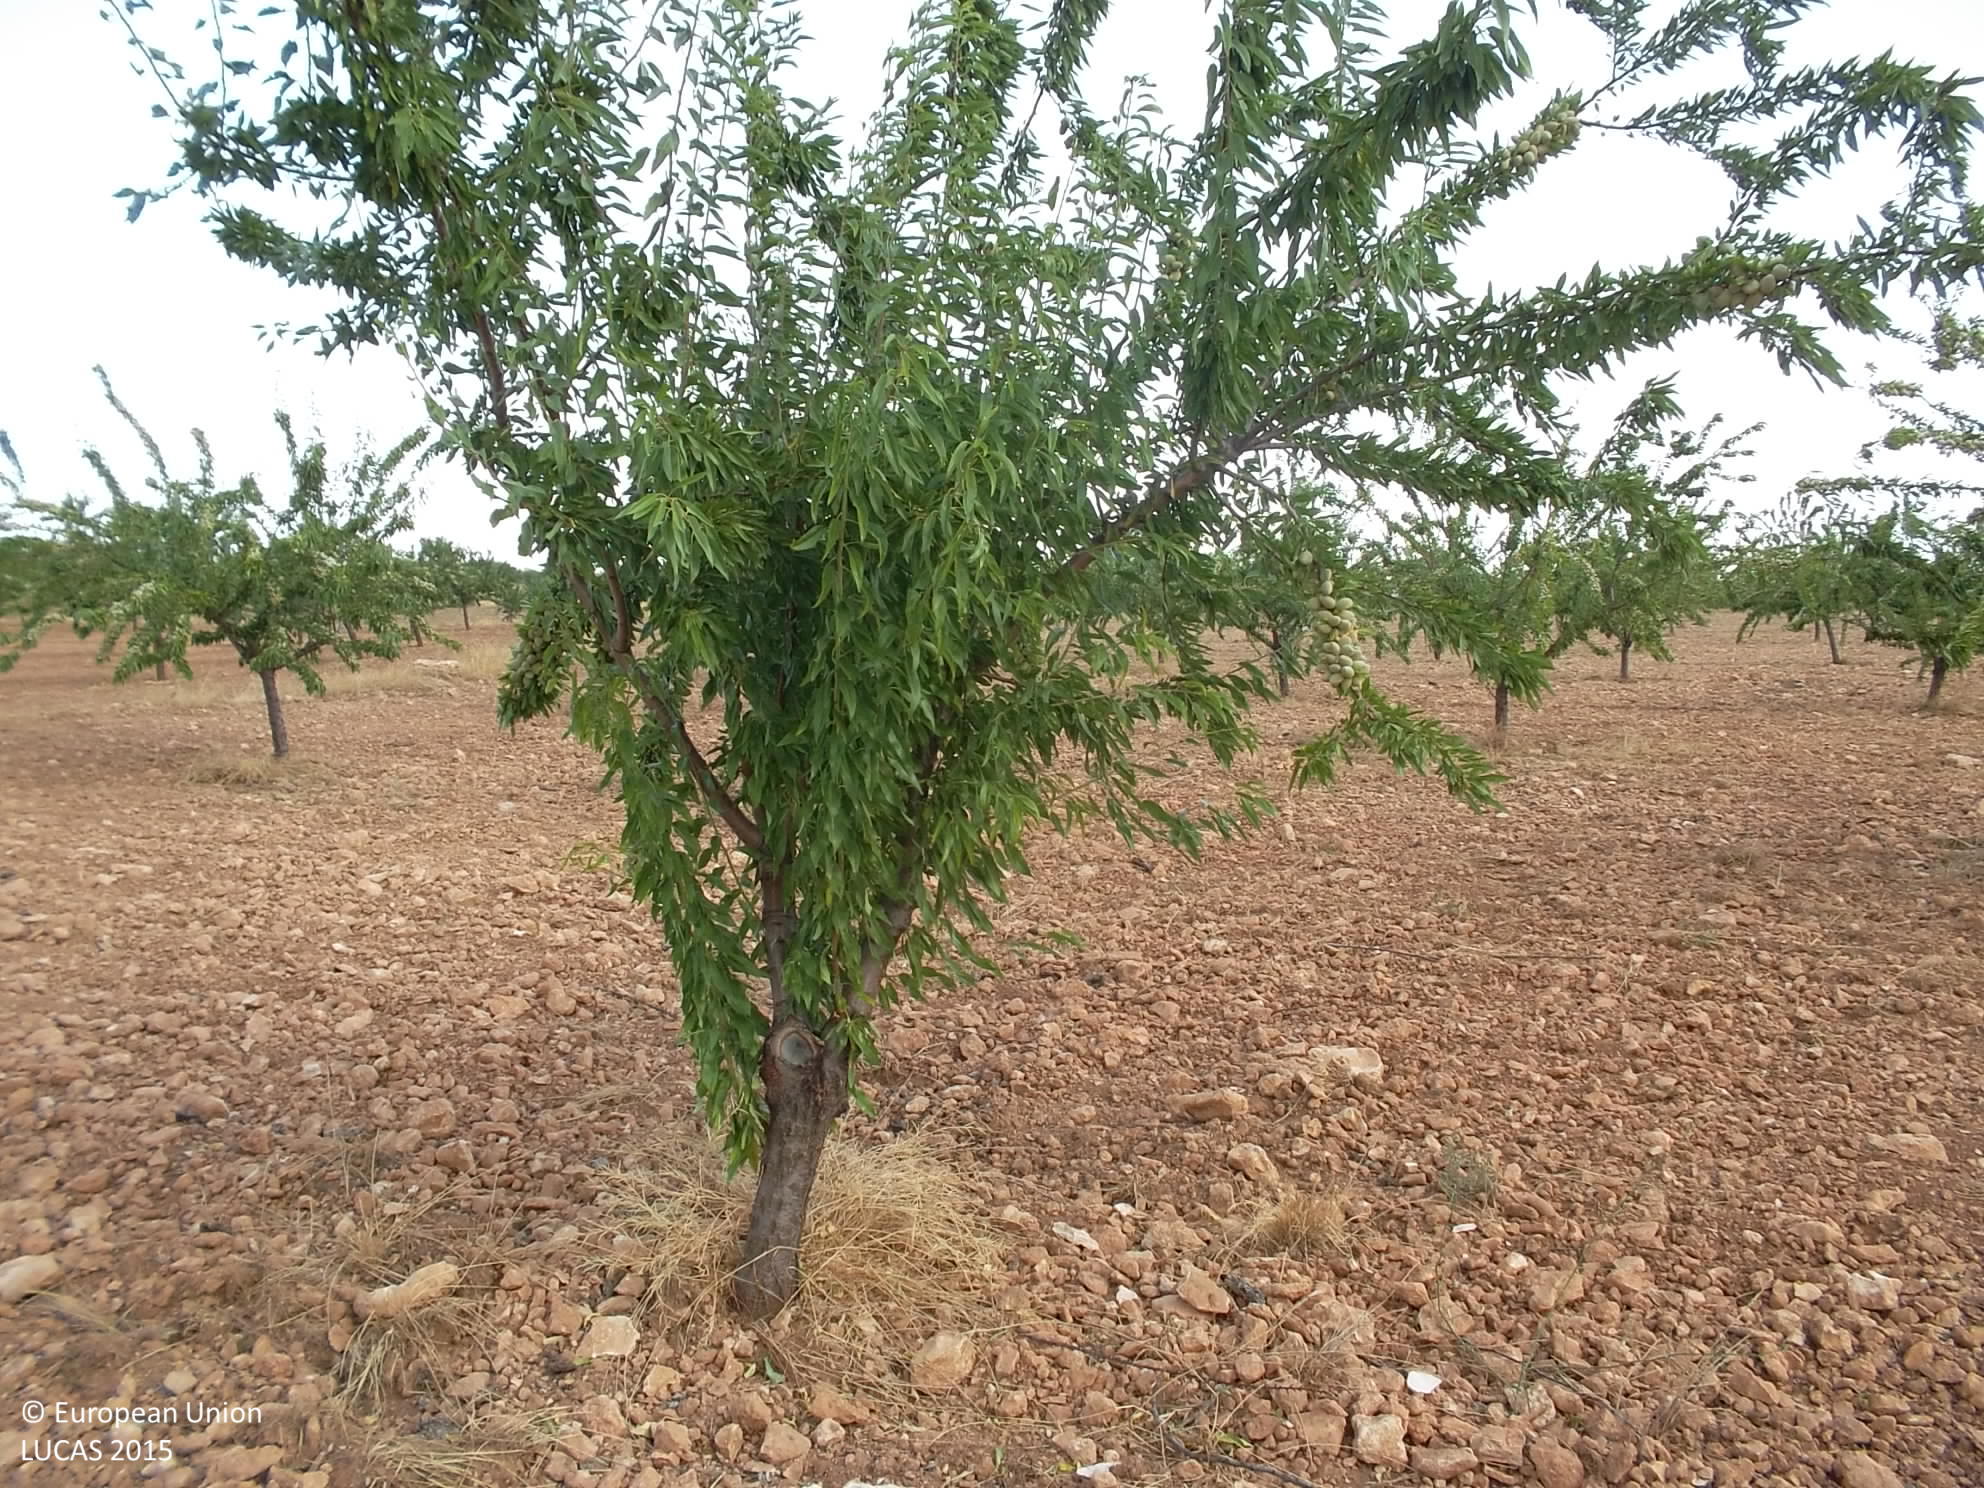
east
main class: Cropland
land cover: Nuts trees
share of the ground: 25 - 50 %
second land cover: Other bare soil
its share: > 75 %
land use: Agriculture (excluding fallow land and kitchen gardens)
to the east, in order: Nuts trees; Other bare soil; Grass margins; Nuts trees; Grass margins; Nuts trees; Grassland without tree/shrub cover
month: July
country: ES
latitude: 37.7252
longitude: -2.7771
